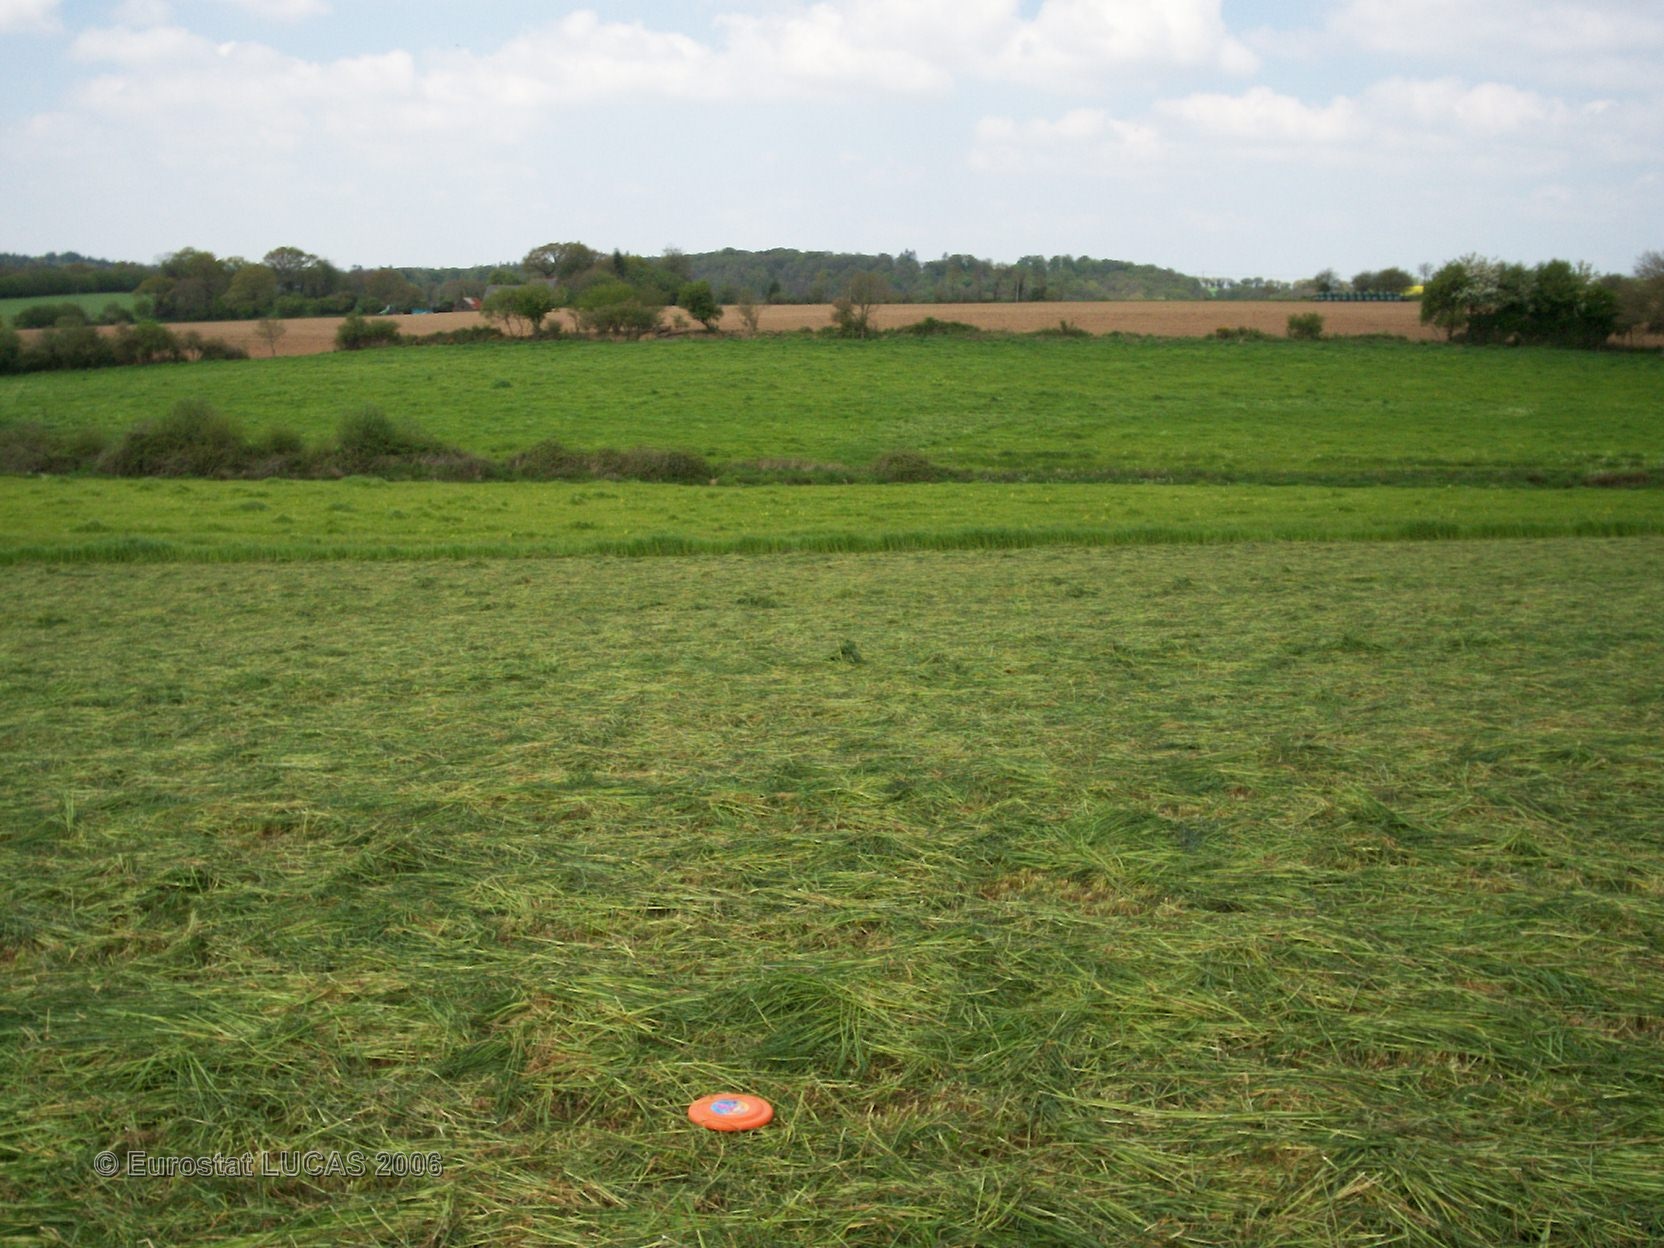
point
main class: Grassland
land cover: Grassland without tree/shrub cover
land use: Agriculture (excluding fallow land and kitchen gardens)
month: May
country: FR
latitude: 48.3347
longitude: -3.6657
